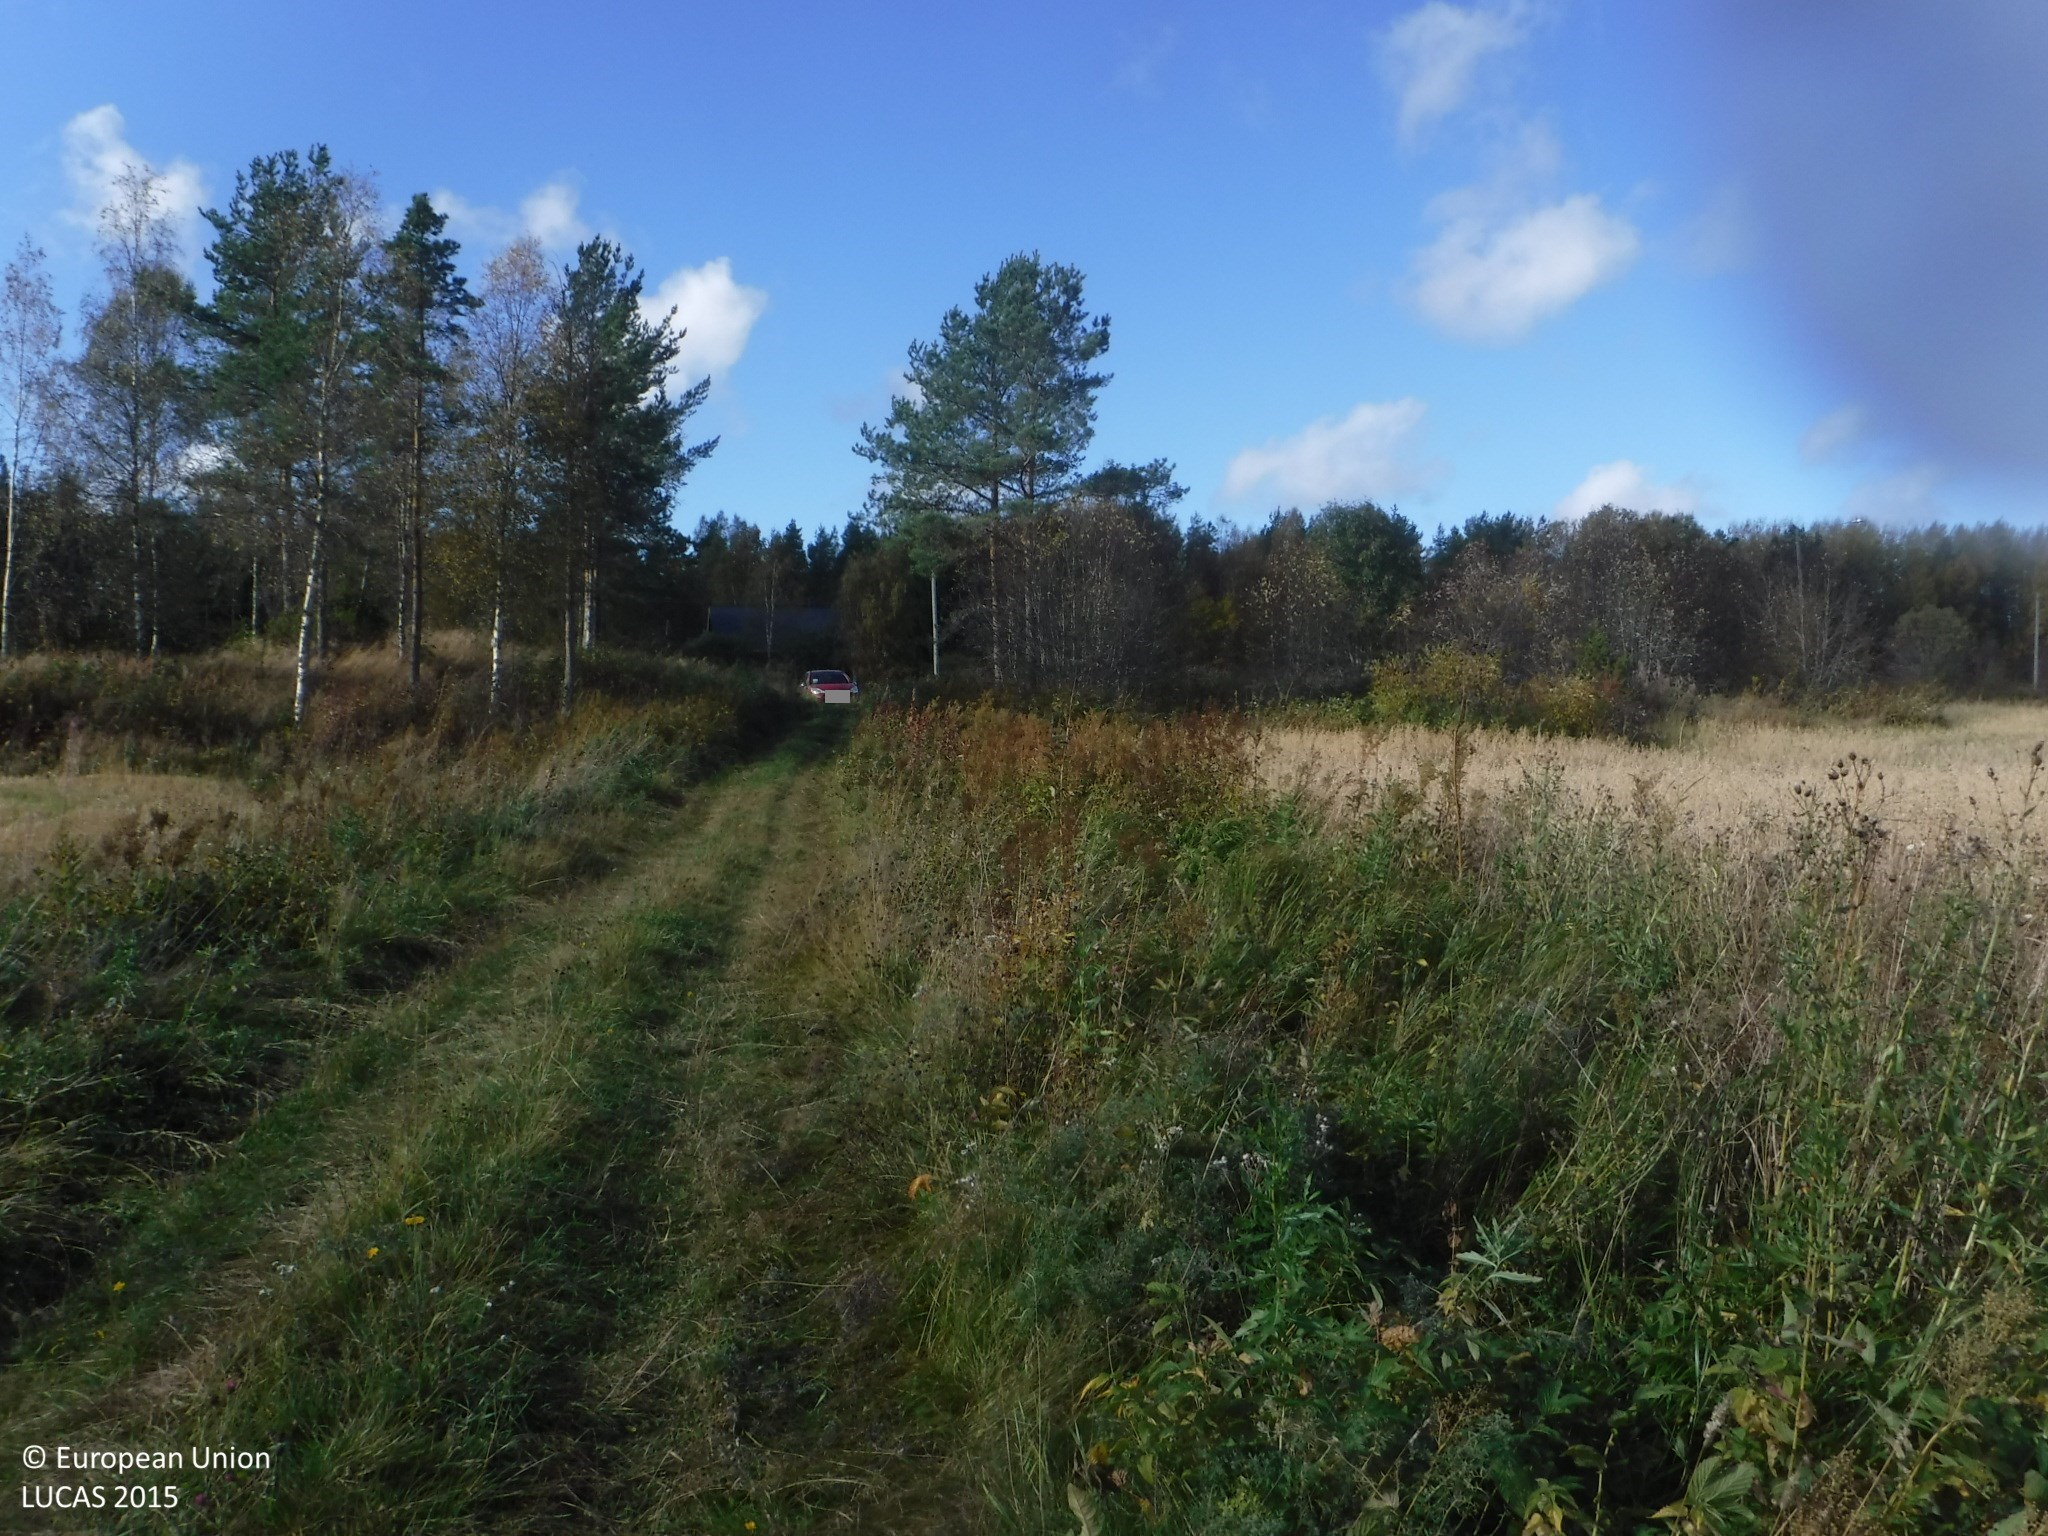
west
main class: Cropland
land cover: Oats
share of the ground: > 75 %
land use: Agriculture (excluding fallow land and kitchen gardens)
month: September
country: FI
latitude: 62.1460
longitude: 21.5774
